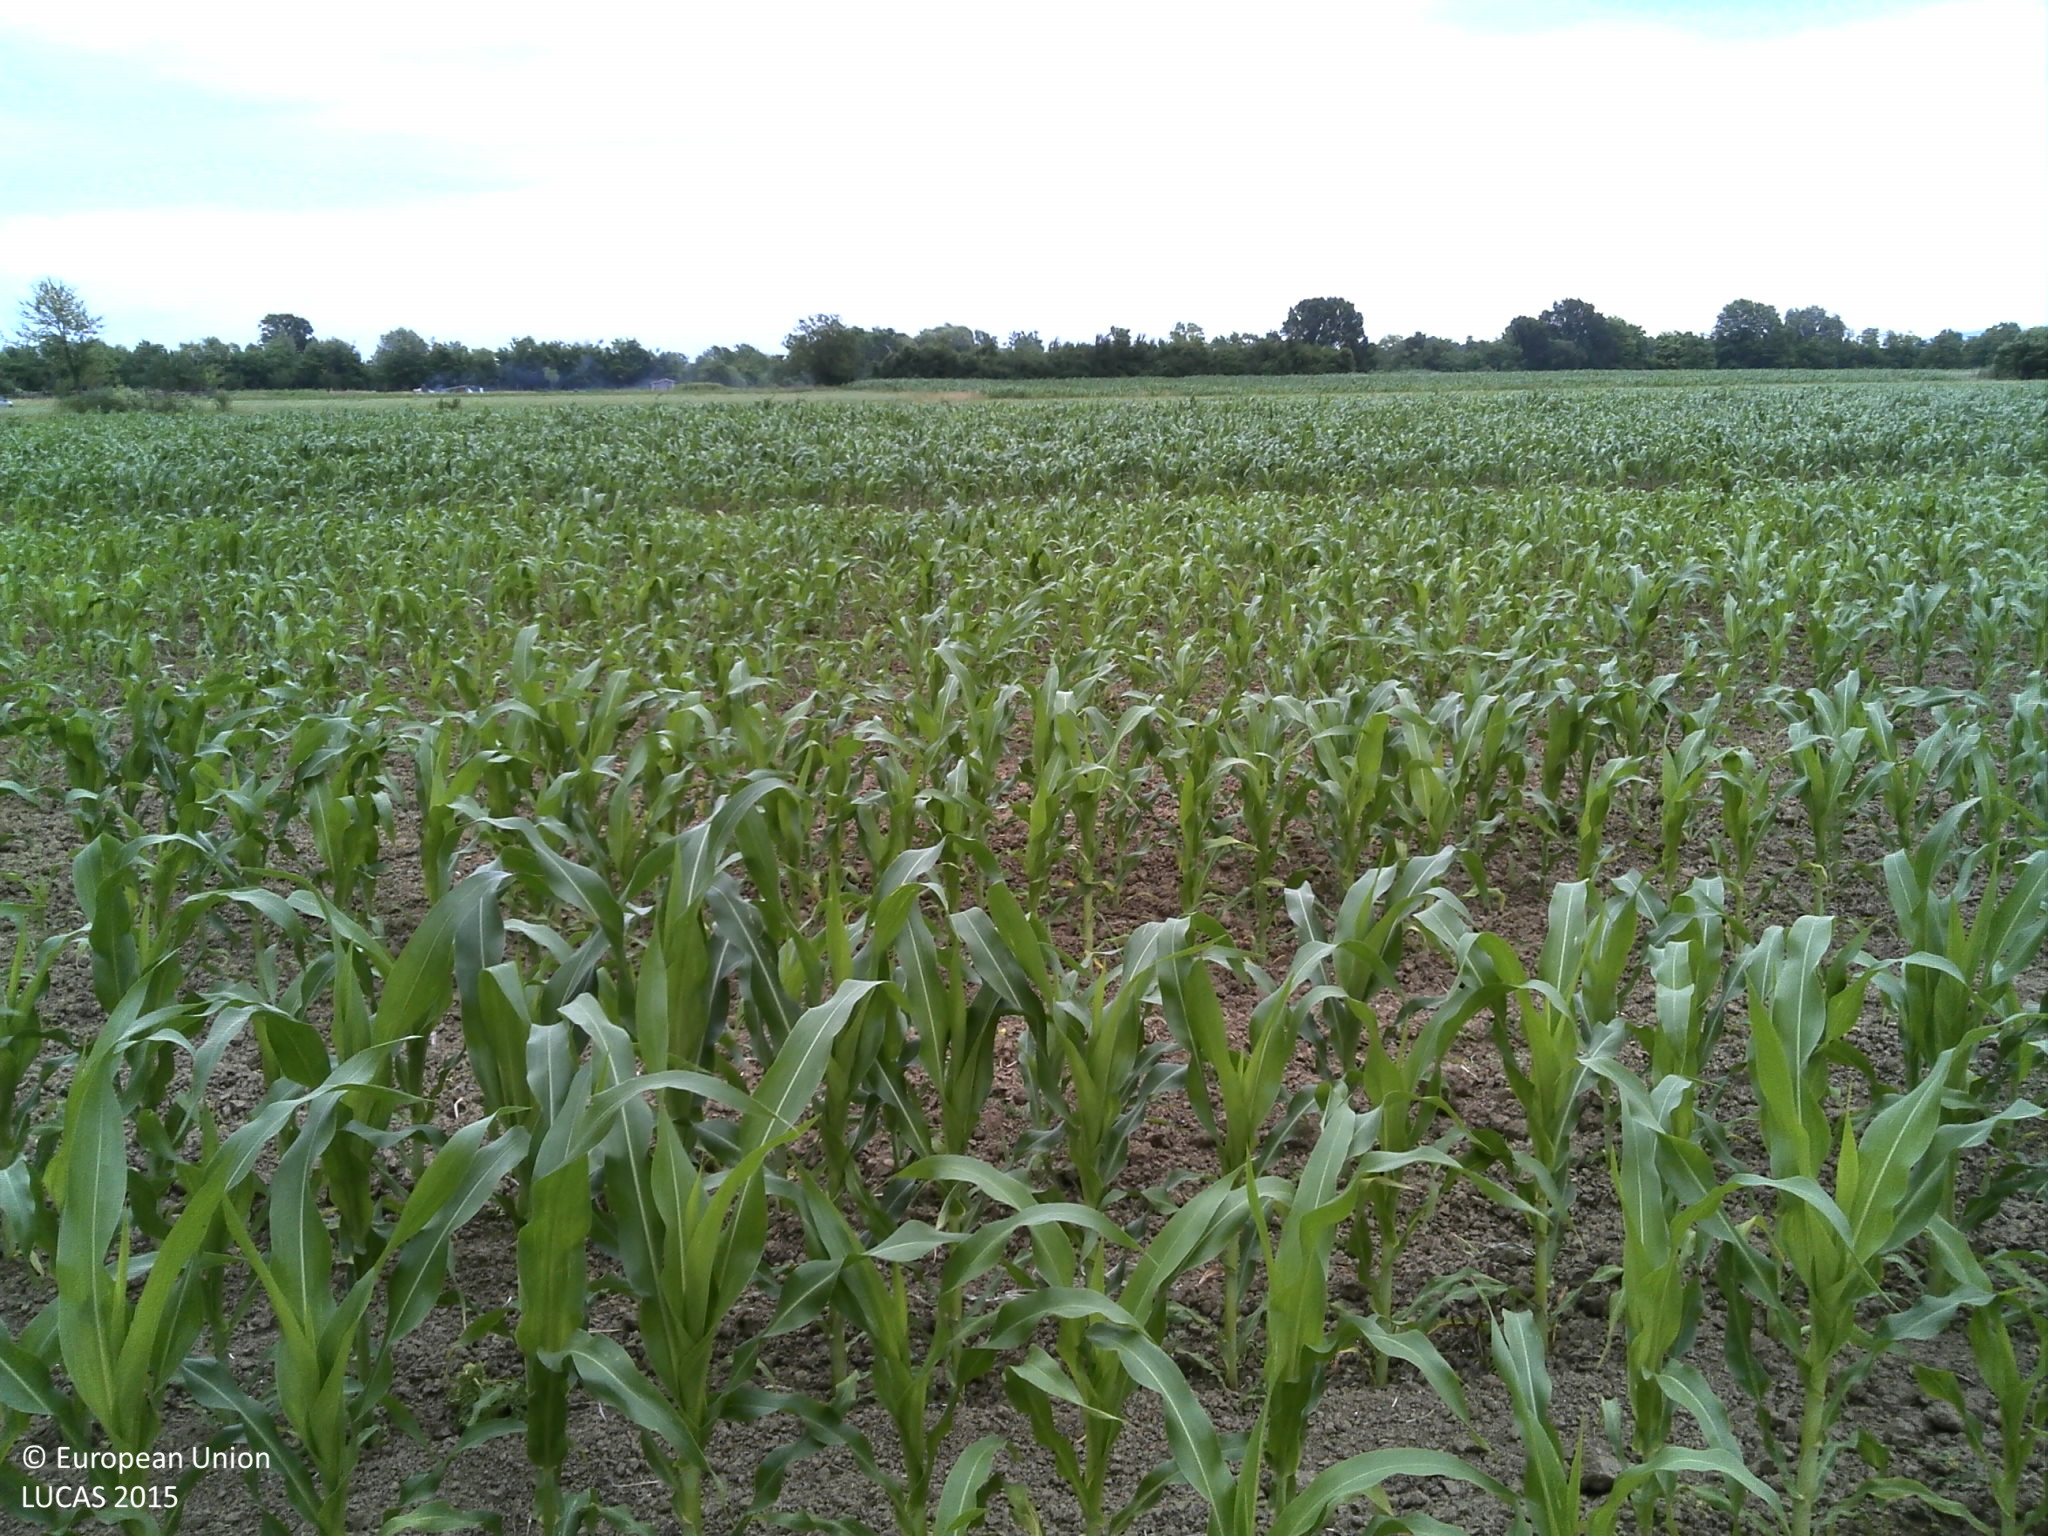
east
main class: Cropland
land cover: Maize
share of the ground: 50 - 75 %
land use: Agriculture (excluding fallow land and kitchen gardens)
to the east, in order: Maize; Grass margins; Maize; Grass margins; Lucerne; Other fresh vegetables; Oats; Grassland without tree/shrub cover; Maize
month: June
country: HR
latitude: 45.2390
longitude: 17.4782
